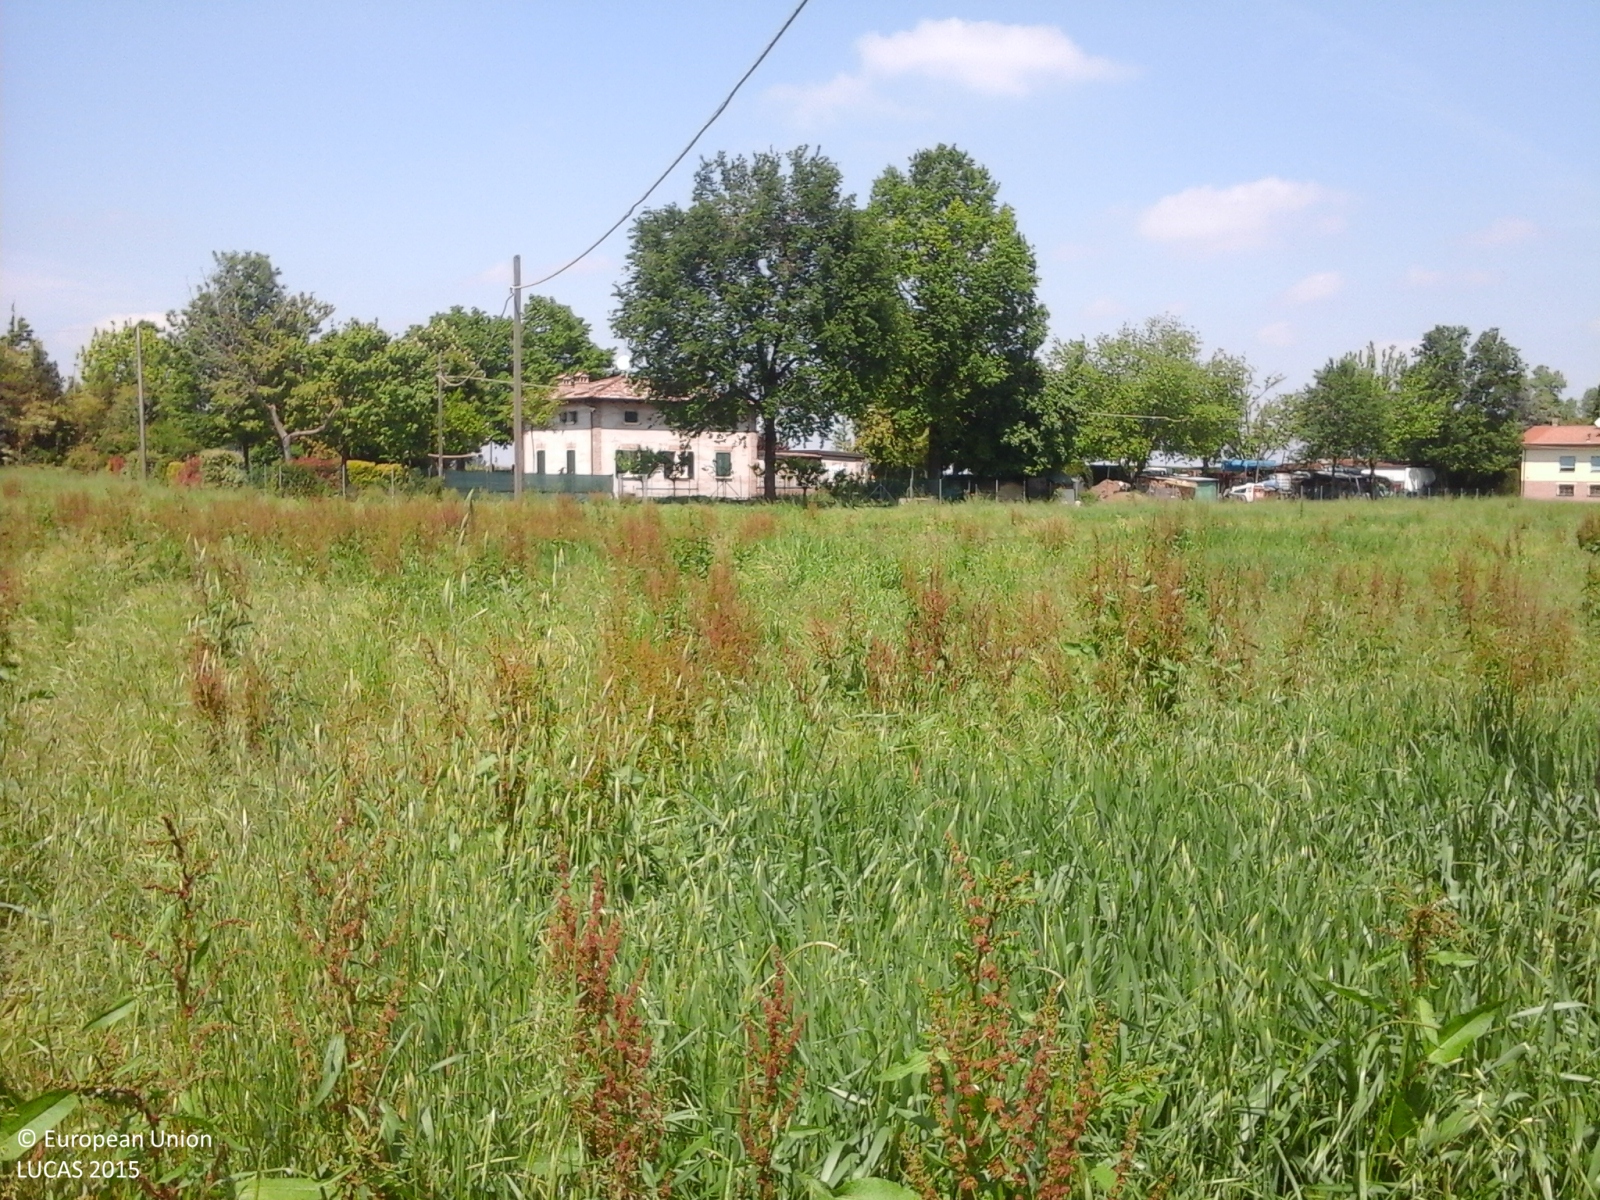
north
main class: Grassland
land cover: Spontaneously vegetated surfaces
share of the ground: > 75 %
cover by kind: herbaceous plants 100 %
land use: Agriculture (excluding fallow land and kitchen gardens)
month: May
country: IT
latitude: 44.5634
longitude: 10.8669
